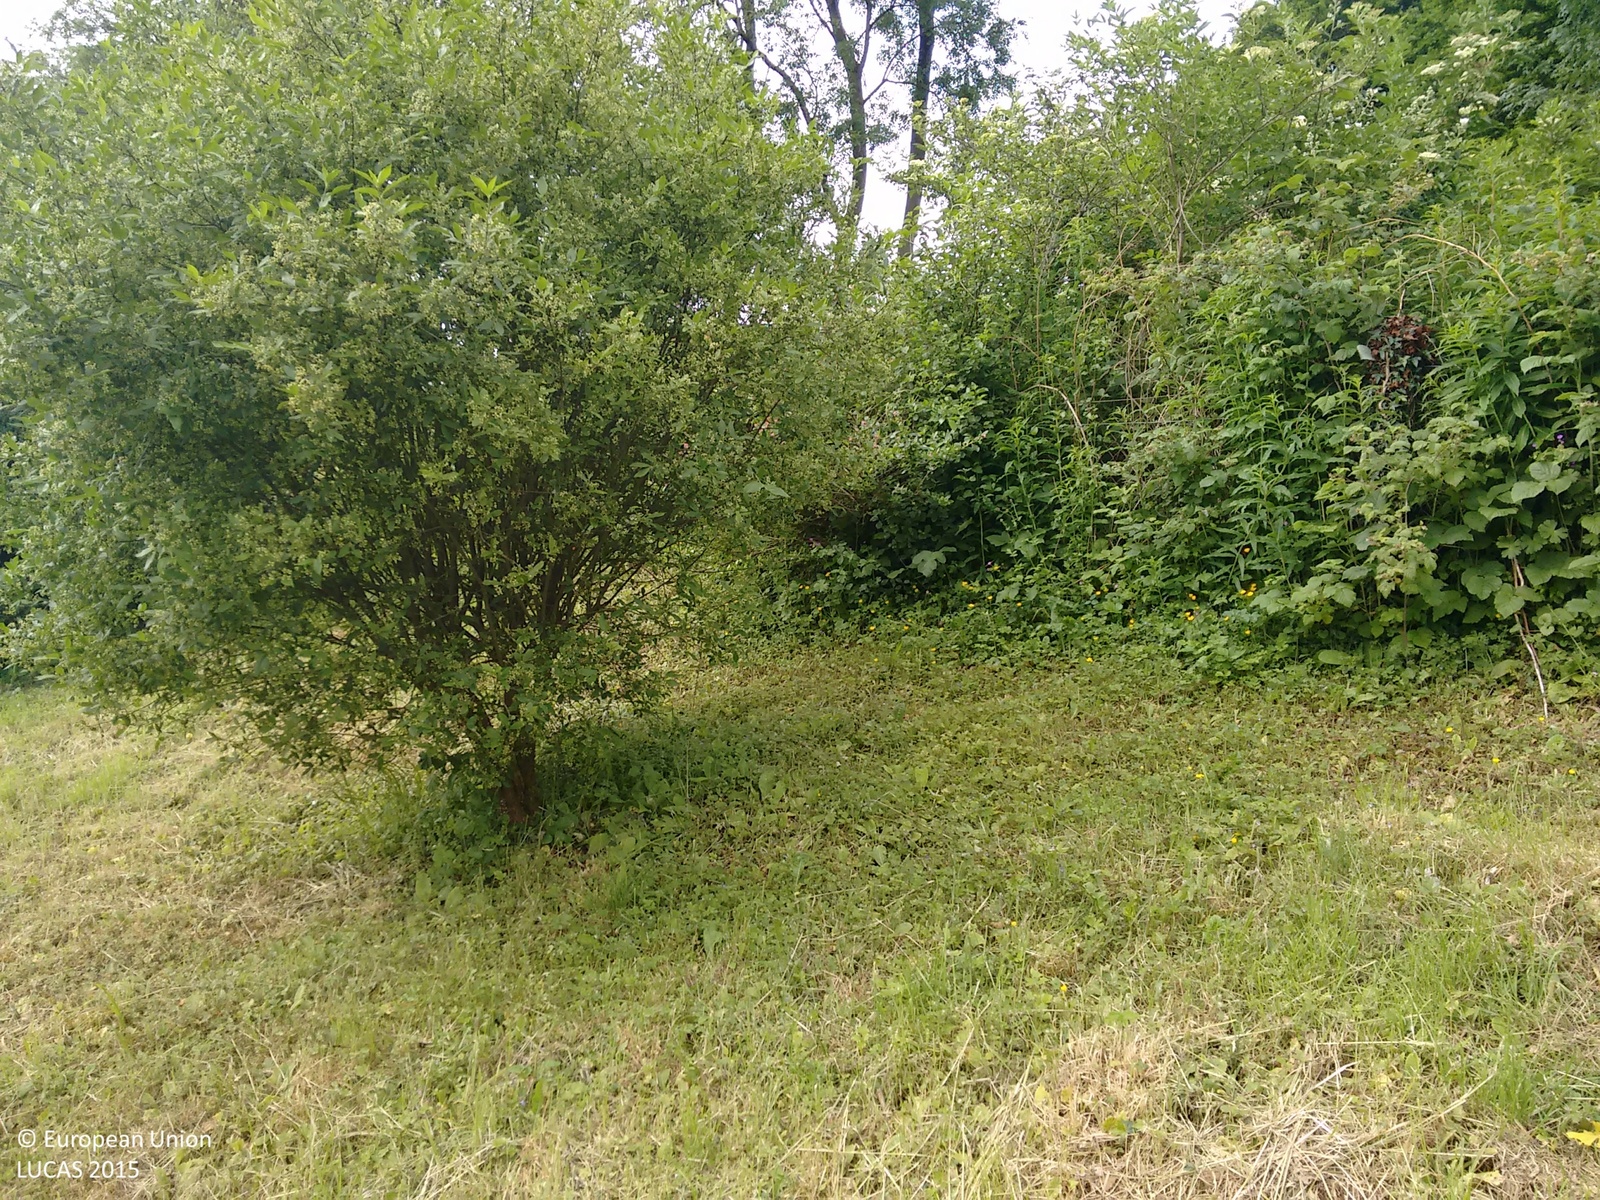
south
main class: Grassland
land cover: Grassland with sparse tree/shrub cover
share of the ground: > 75 %
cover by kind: herbaceous plants 95 %, broadleaved forest trees 5 %
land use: Residential
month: June
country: GB
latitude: 51.4106
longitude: -2.2690
